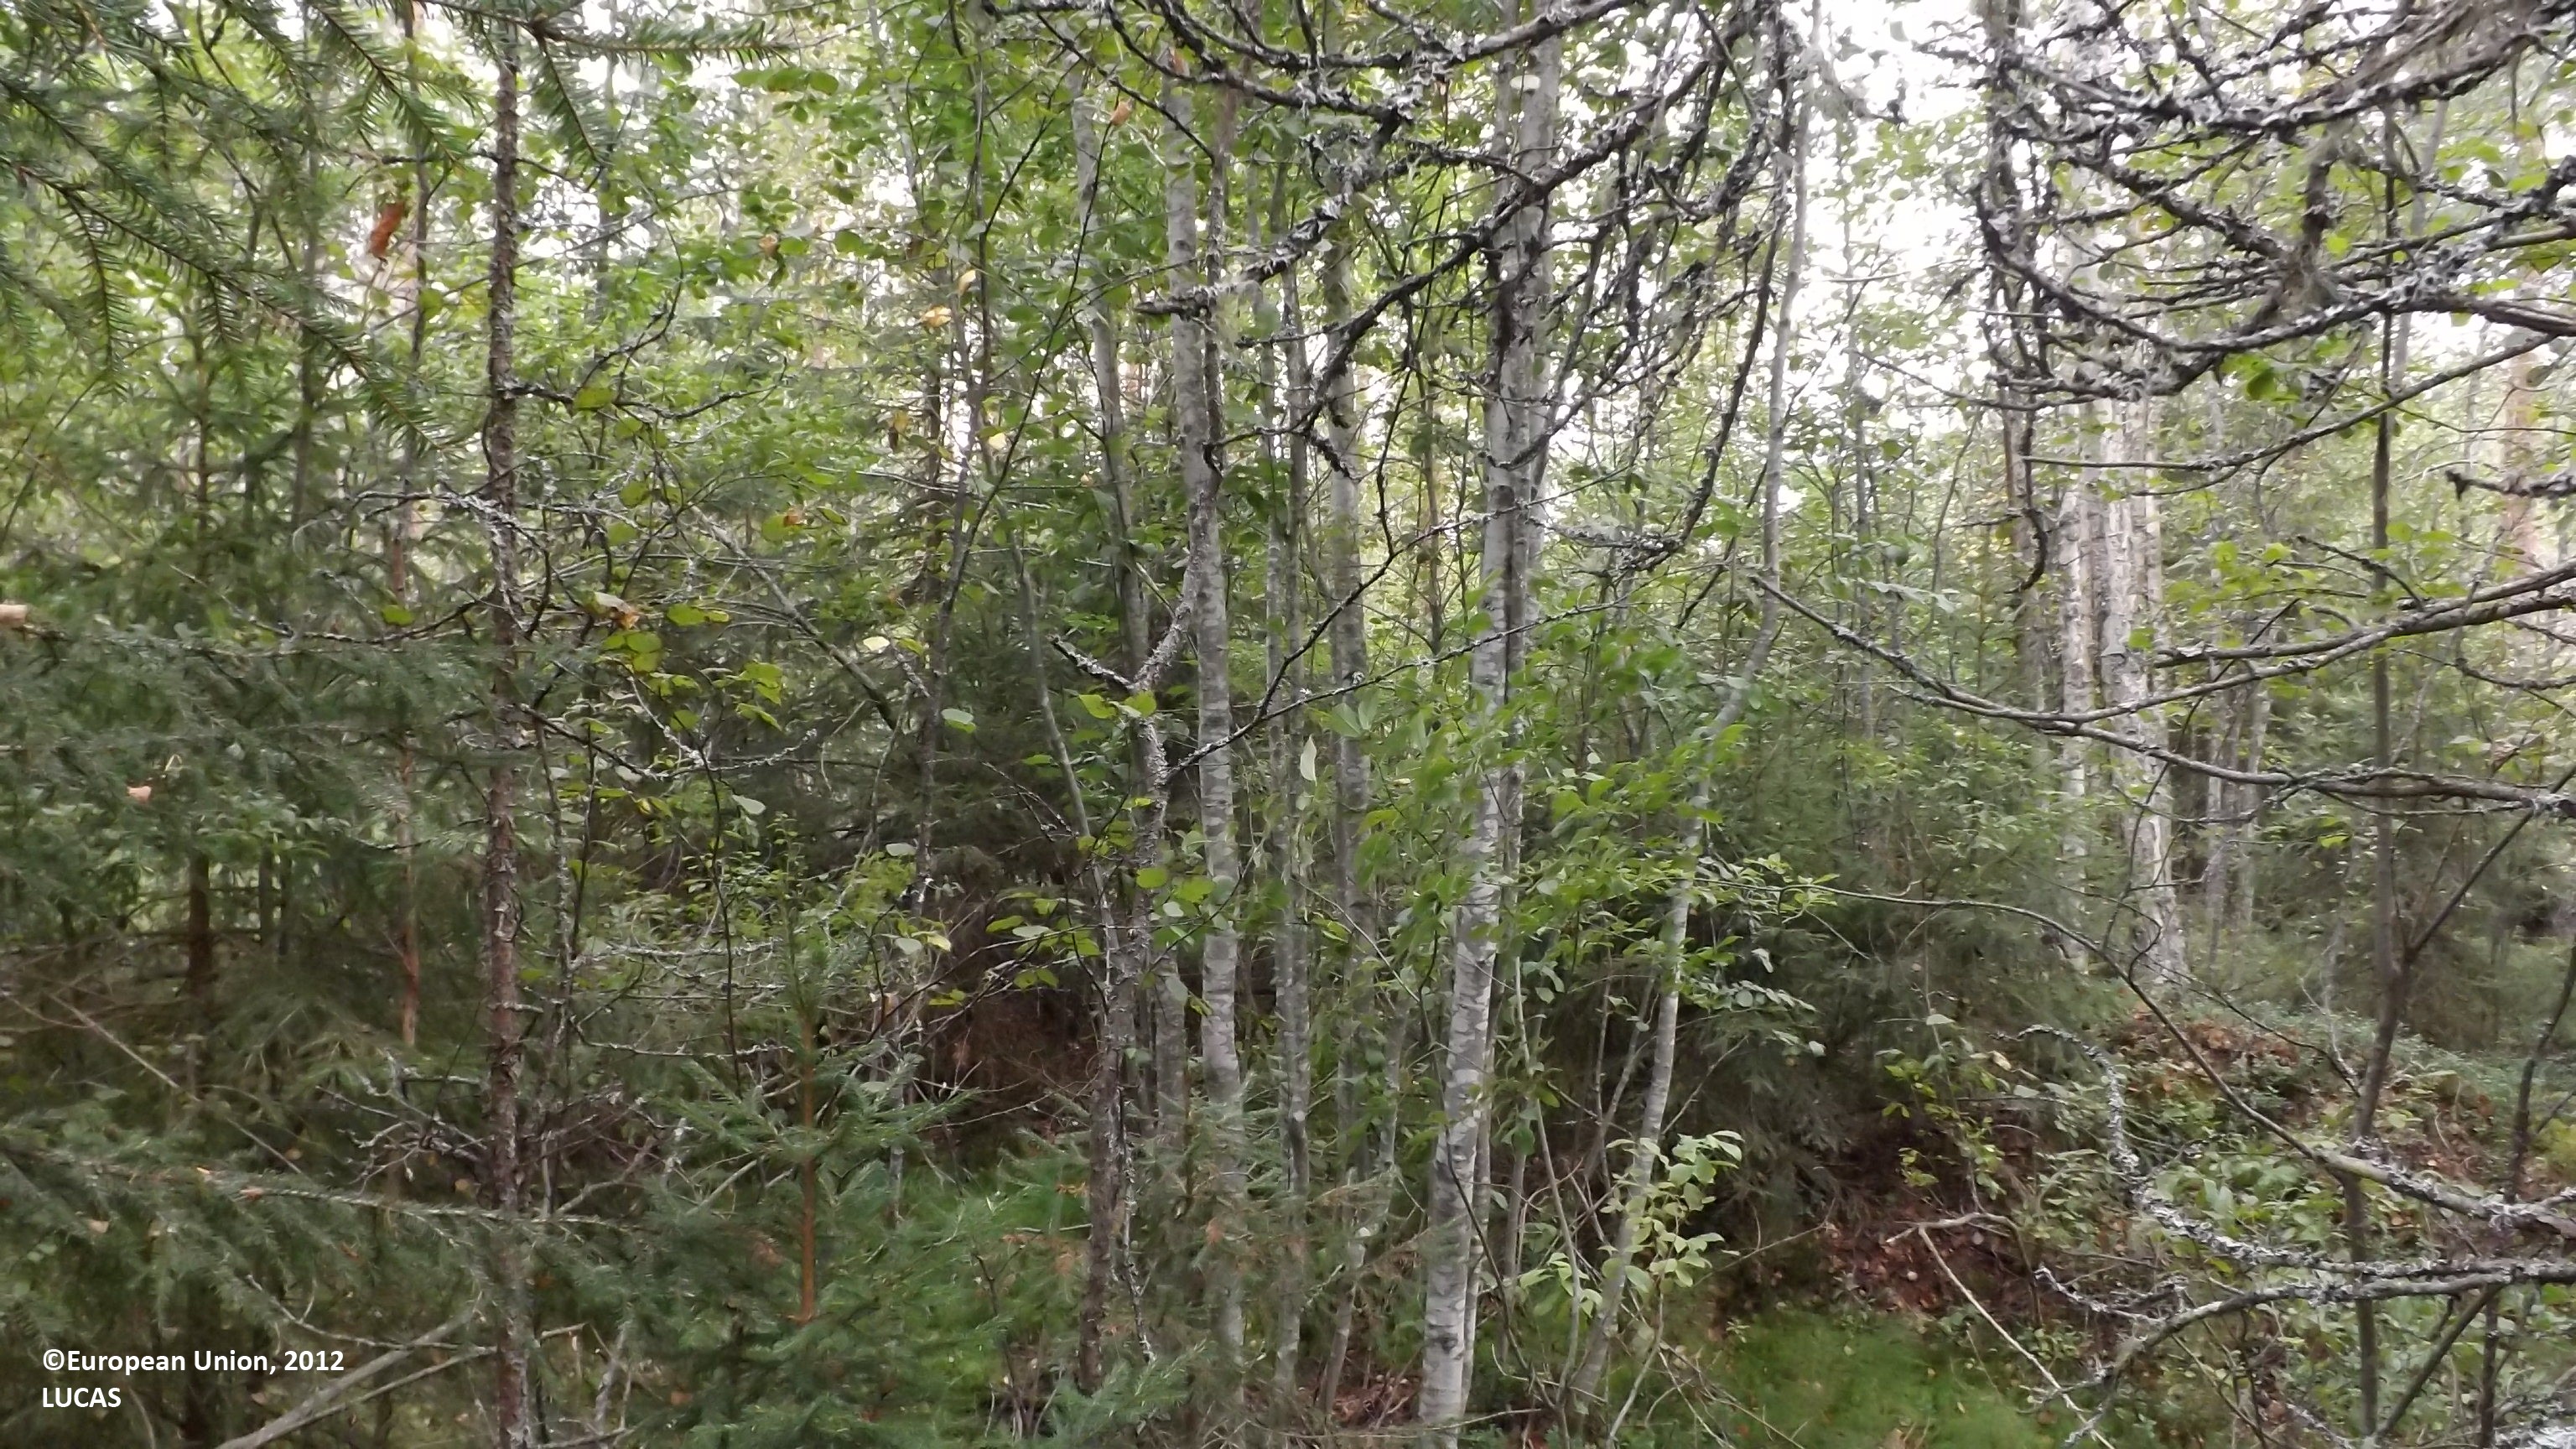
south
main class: Woodland
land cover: Other mixed woodland
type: boreal forest
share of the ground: > 75 %
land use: Forestry
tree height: > 5 m
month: August
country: FI
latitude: 63.8615
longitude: 24.0448
